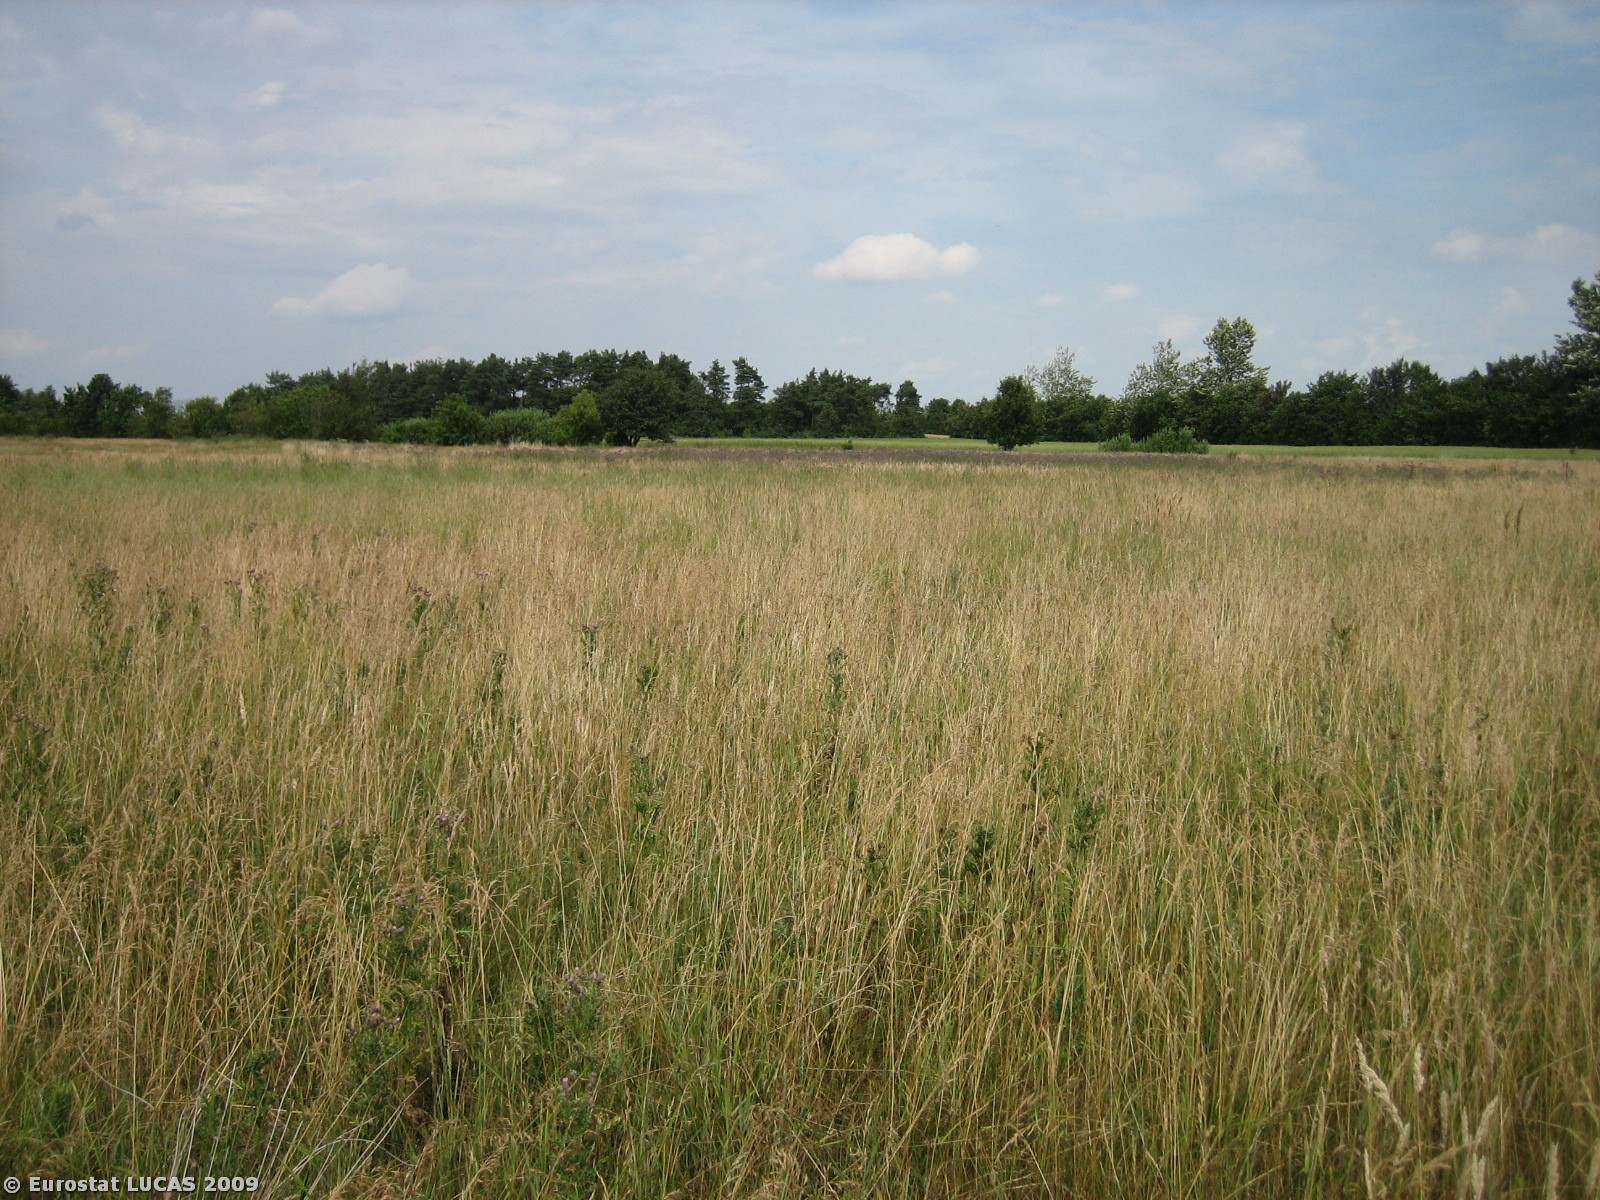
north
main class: Grassland
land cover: Grassland without tree/shrub cover
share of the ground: > 75 %
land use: Fallow land
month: July
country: DK
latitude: 55.8945
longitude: 8.8019
